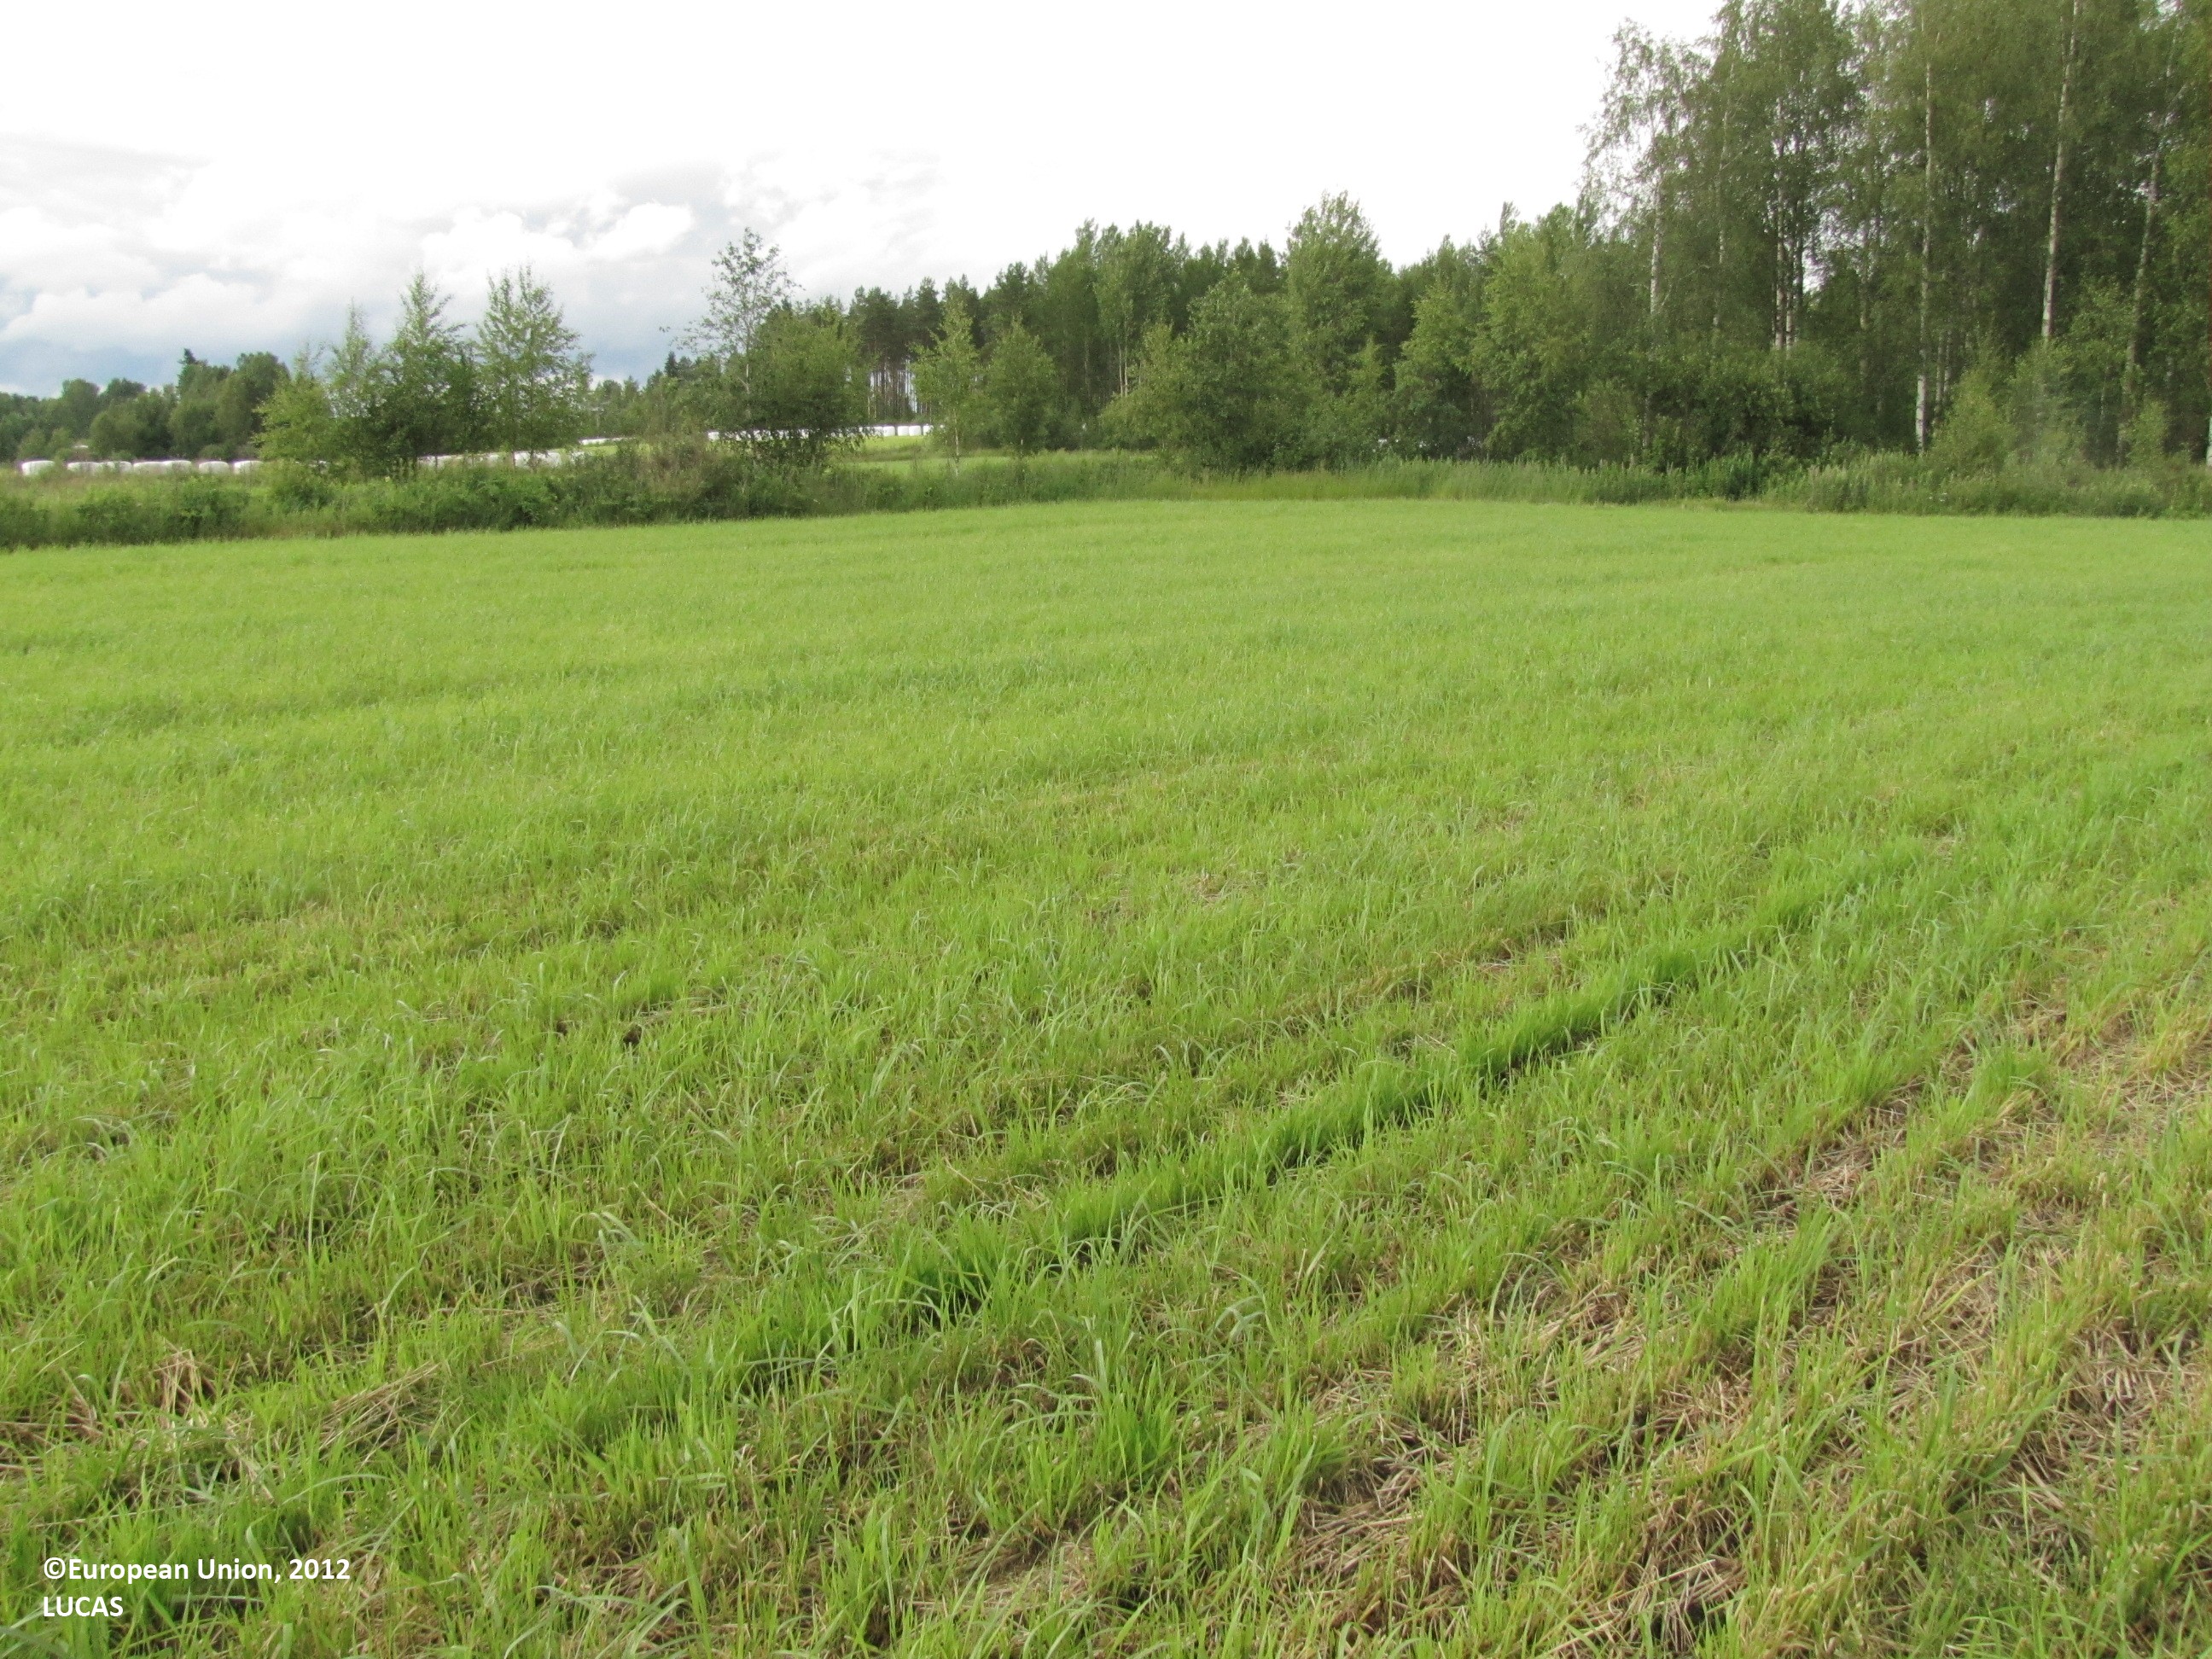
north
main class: Cropland
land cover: Temporary grasslands
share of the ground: > 75 %
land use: Agriculture (excluding fallow land and kitchen gardens)
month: July
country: FI
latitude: 62.4344
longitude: 23.9683
